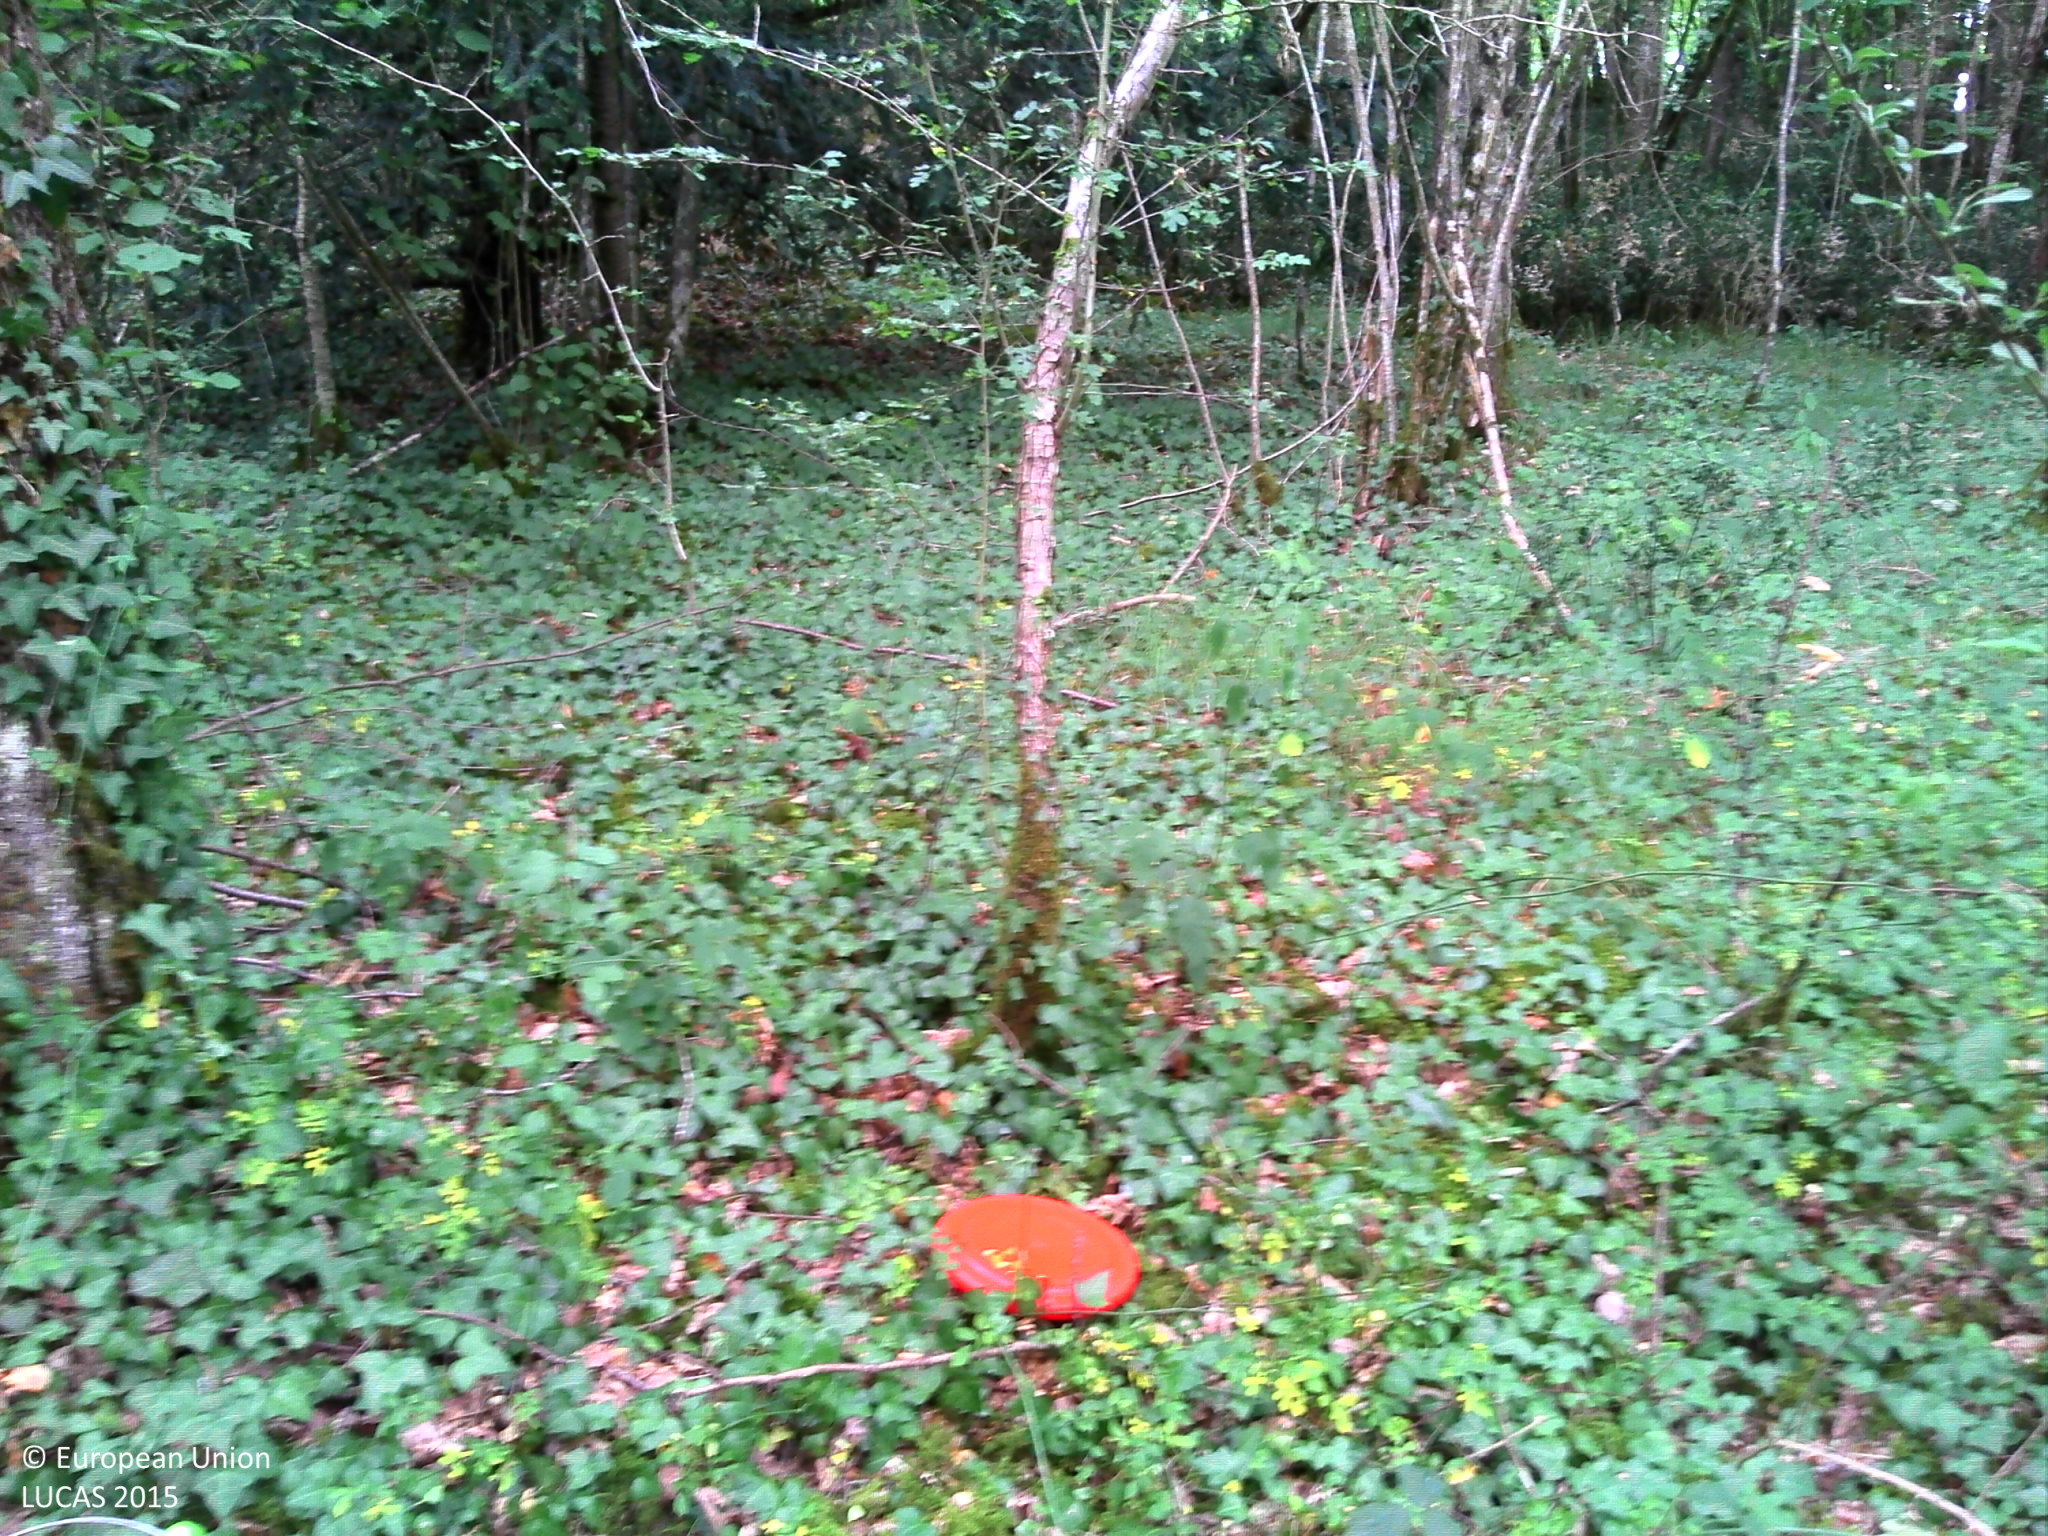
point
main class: Woodland
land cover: Broadleaved woodland
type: mesophytic deciduous forest
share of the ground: > 75 %
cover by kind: broadleaved forest trees 75 %, herbaceous plants 15 %, shrubs 5 %, lichens and mosses 5 %
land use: Forestry
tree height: > 5 m
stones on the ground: < 10 %
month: July
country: FR
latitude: 45.0411
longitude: 1.1452
